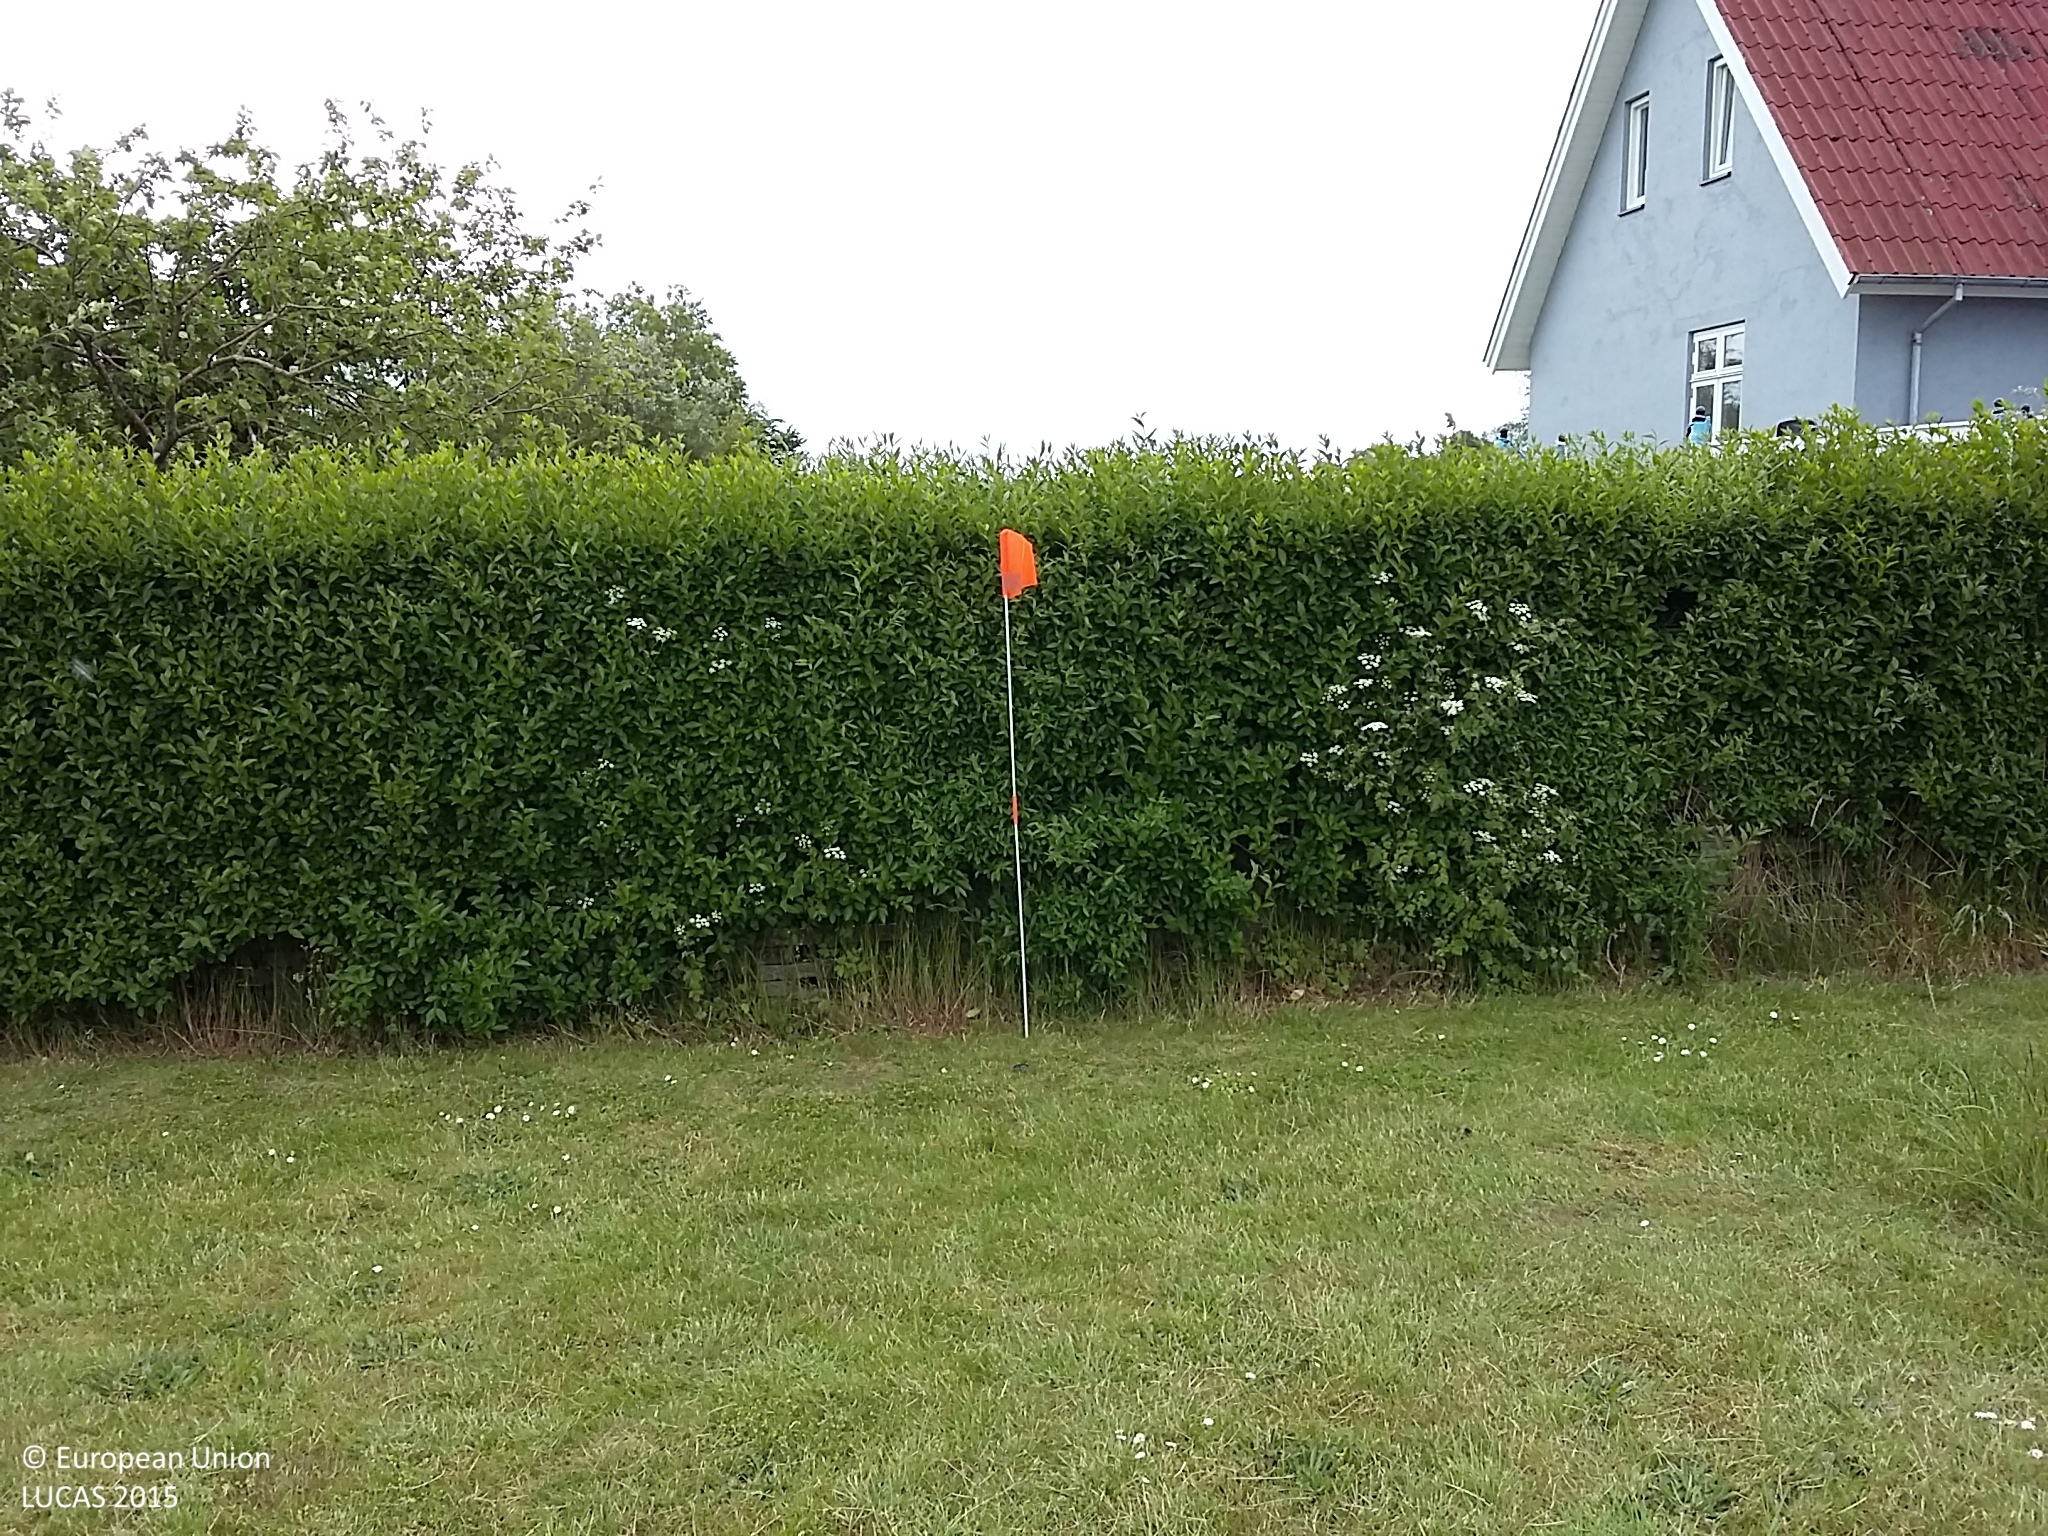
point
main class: Grassland
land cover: Grassland without tree/shrub cover
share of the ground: > 75 %
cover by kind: herbaceous plants 100 %
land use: Residential
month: June
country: DK
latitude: 54.8915
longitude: 10.7322
